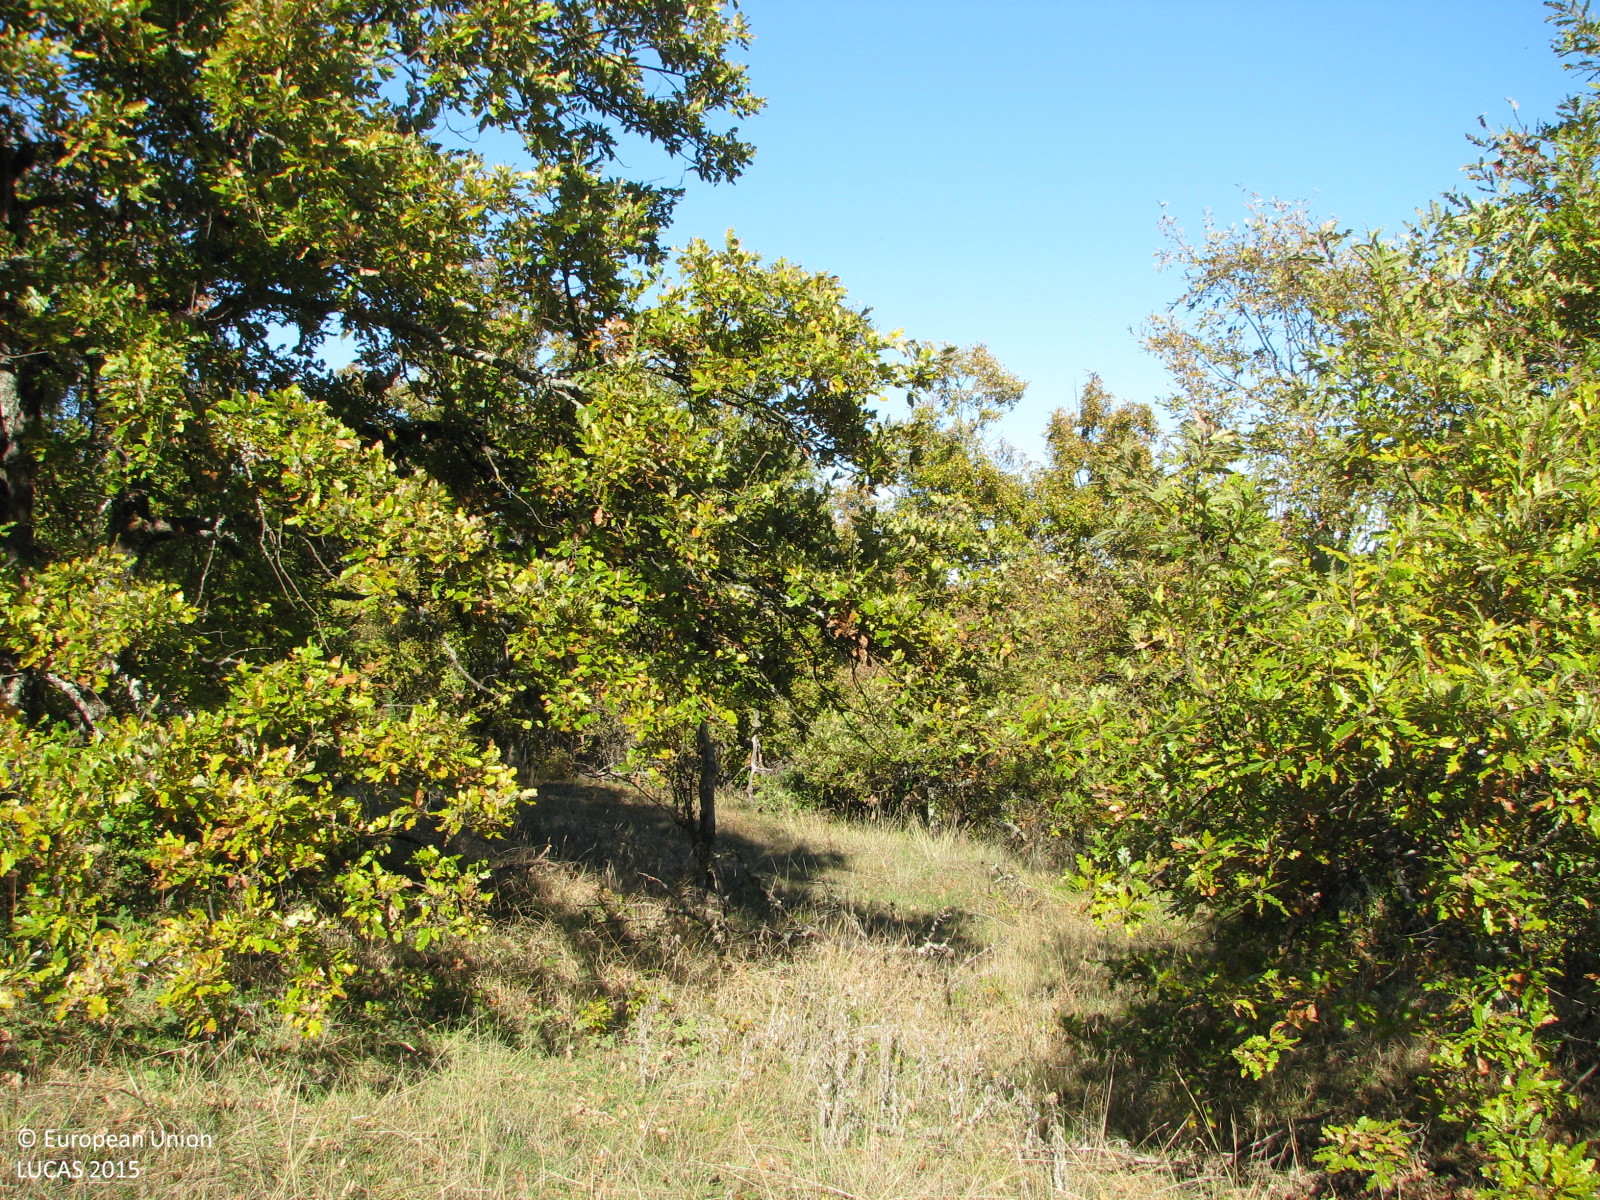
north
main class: Grassland
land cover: Grassland with sparse tree/shrub cover
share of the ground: > 75 %
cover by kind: herbaceous plants 85 %, shrubs 10 %, broadleaved forest trees 5 %
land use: Semi-natural and natural areas not in use
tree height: < 5 m
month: November
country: BG
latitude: 42.0594
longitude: 26.9547
